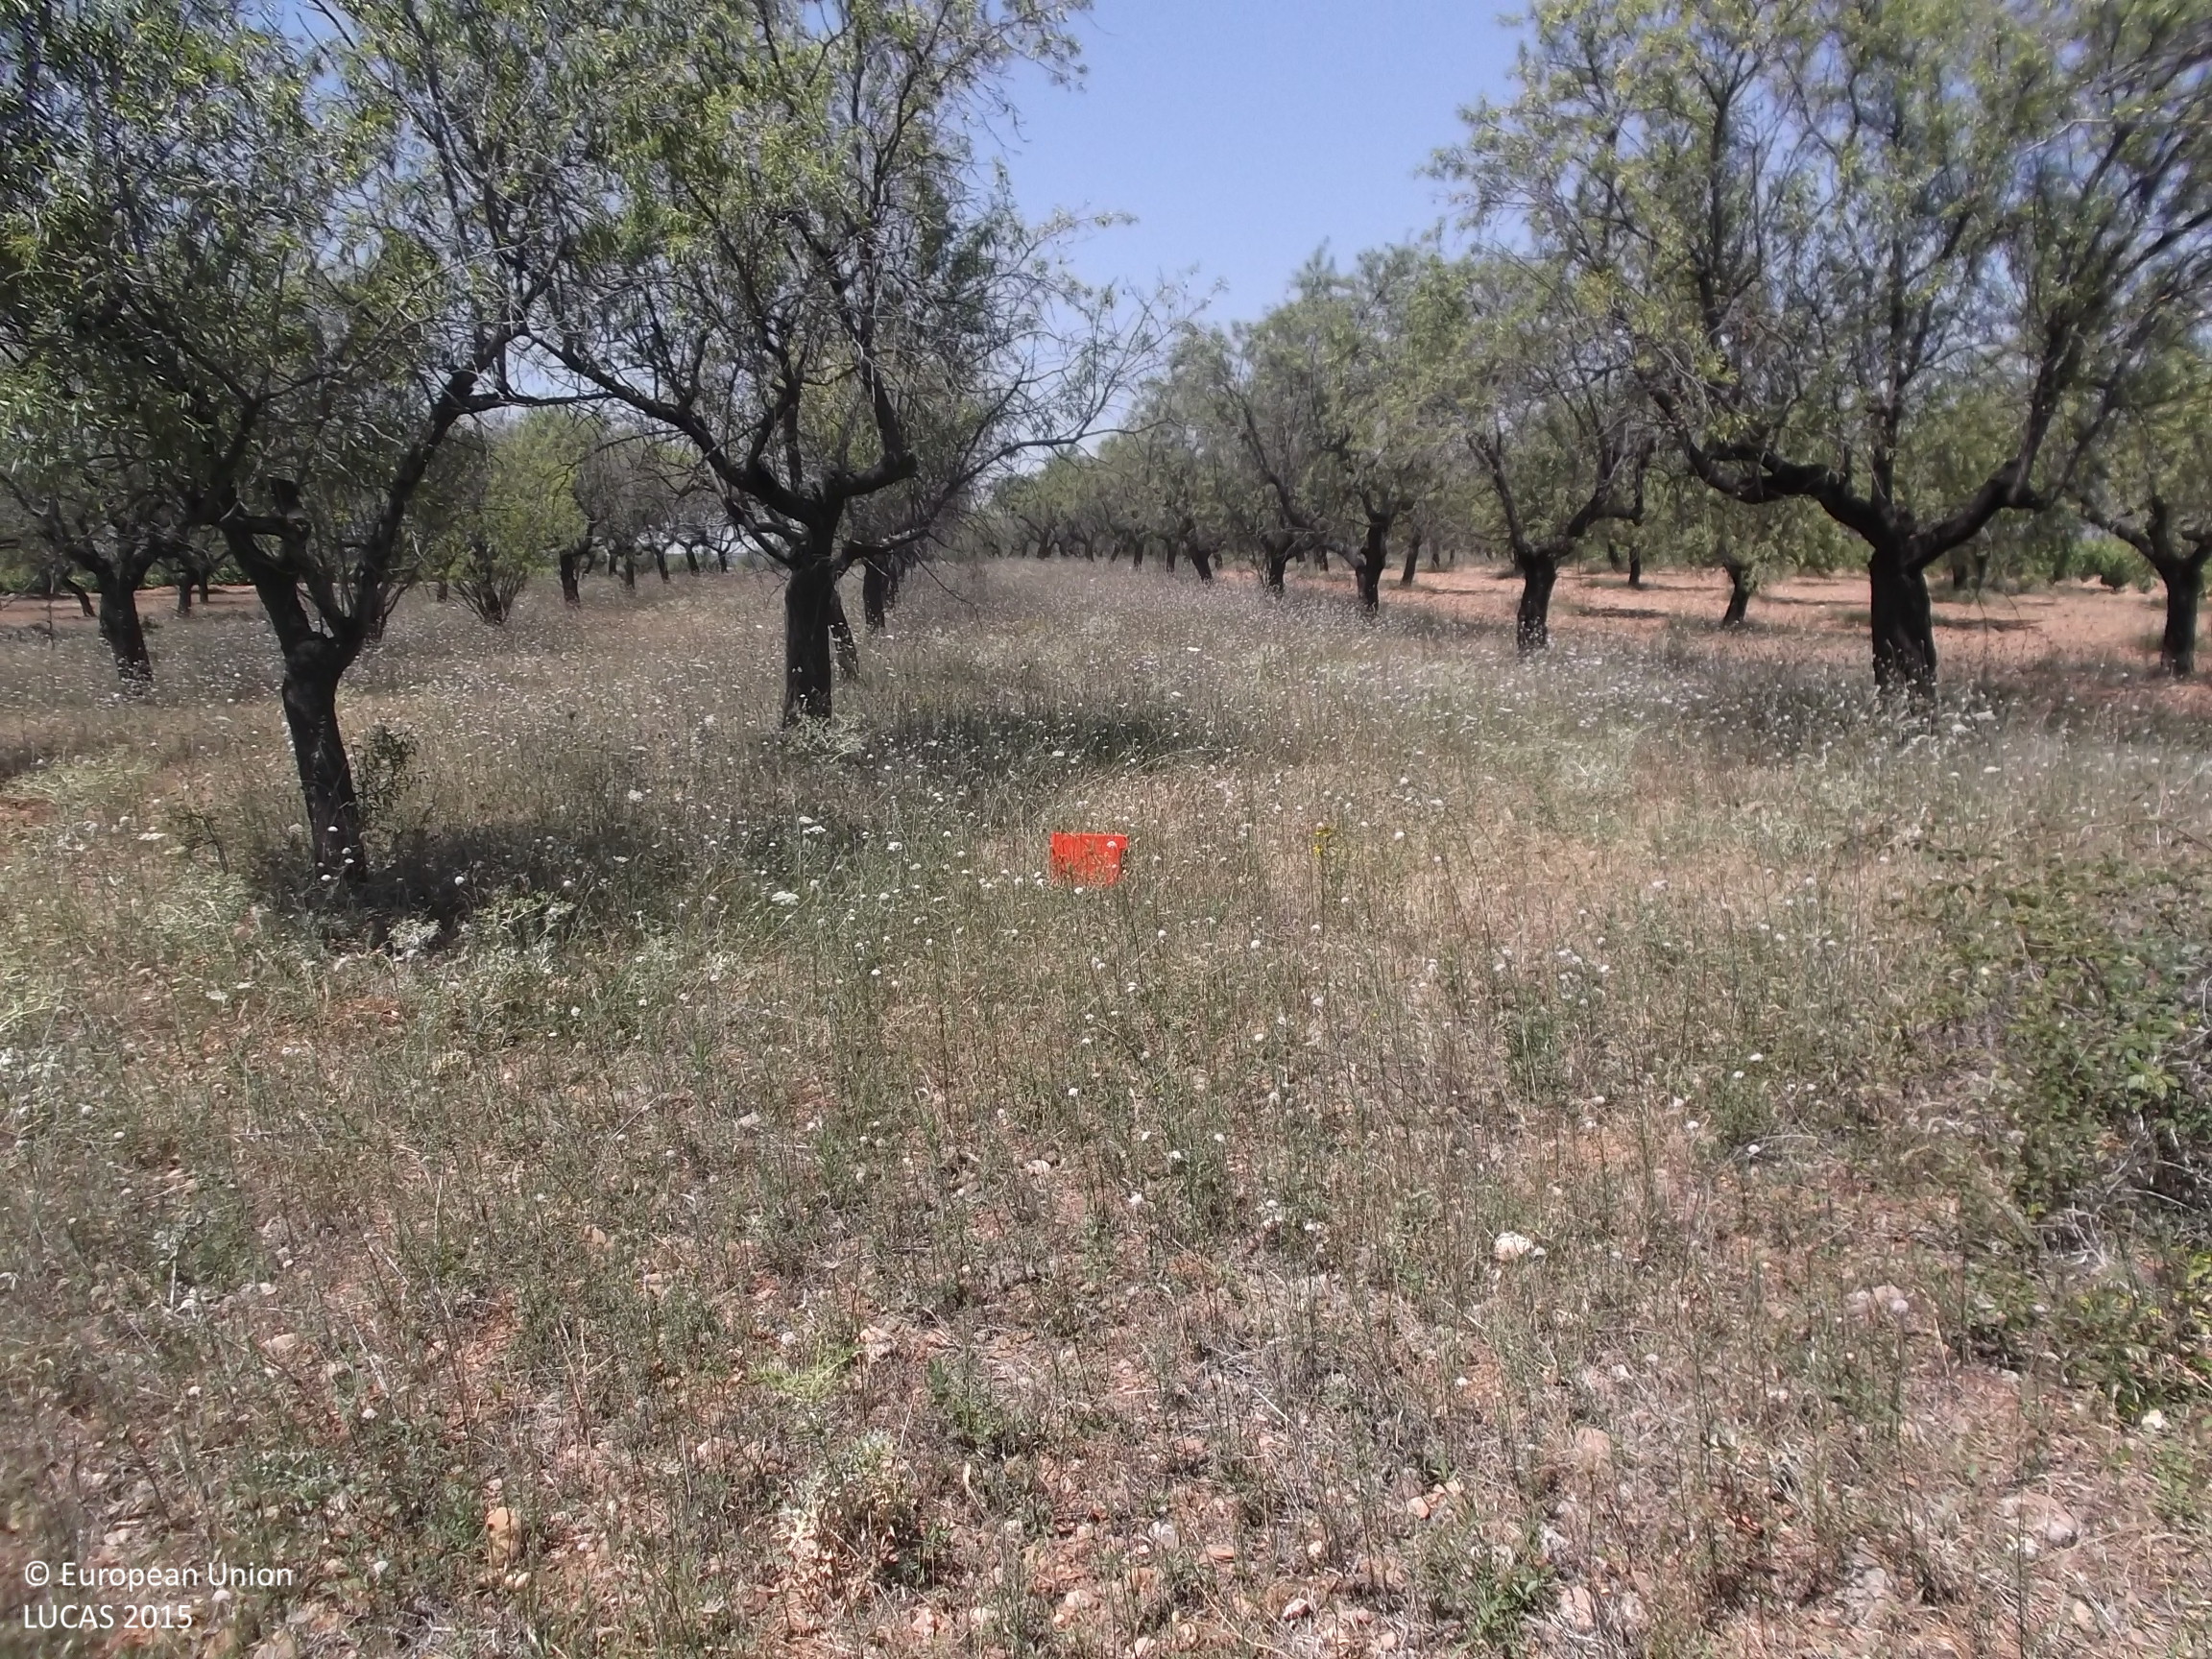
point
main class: Cropland
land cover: Nuts trees
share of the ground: 10 - 25 %
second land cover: Spontaneously vegetated surfaces
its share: > 75 %
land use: Agriculture (excluding fallow land and kitchen gardens)
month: June
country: ES
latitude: 42.2927
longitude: -2.0826
